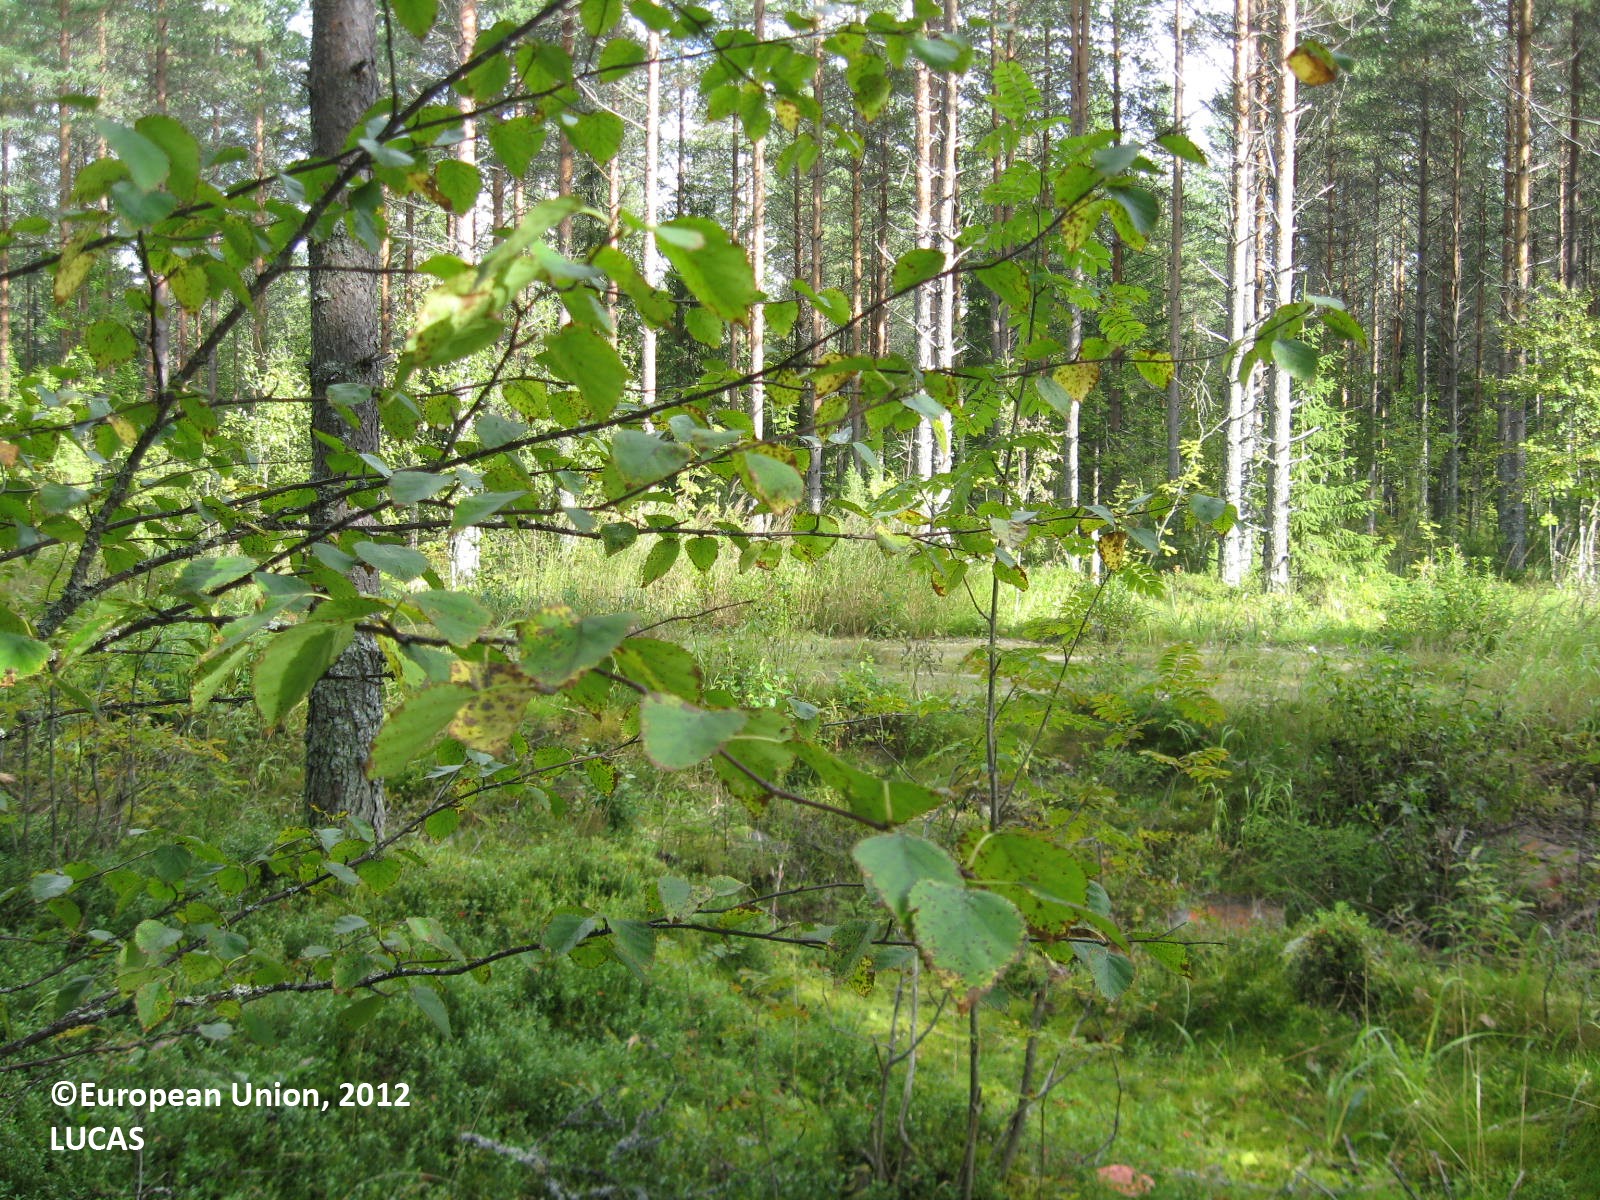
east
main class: Woodland
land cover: Pine dominated coniferous woodland
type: boreal forest
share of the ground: > 75 %
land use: Forestry
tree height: > 5 m
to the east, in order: Pine dominated coniferous woodland; Ditches and canals; Shruby margins; Tracks; Shruby margins; Ditches and canals; Other coniferous woodland; Ditches and canals; Other coniferous woodland
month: August
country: FI
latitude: 63.6163
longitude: 29.3613
